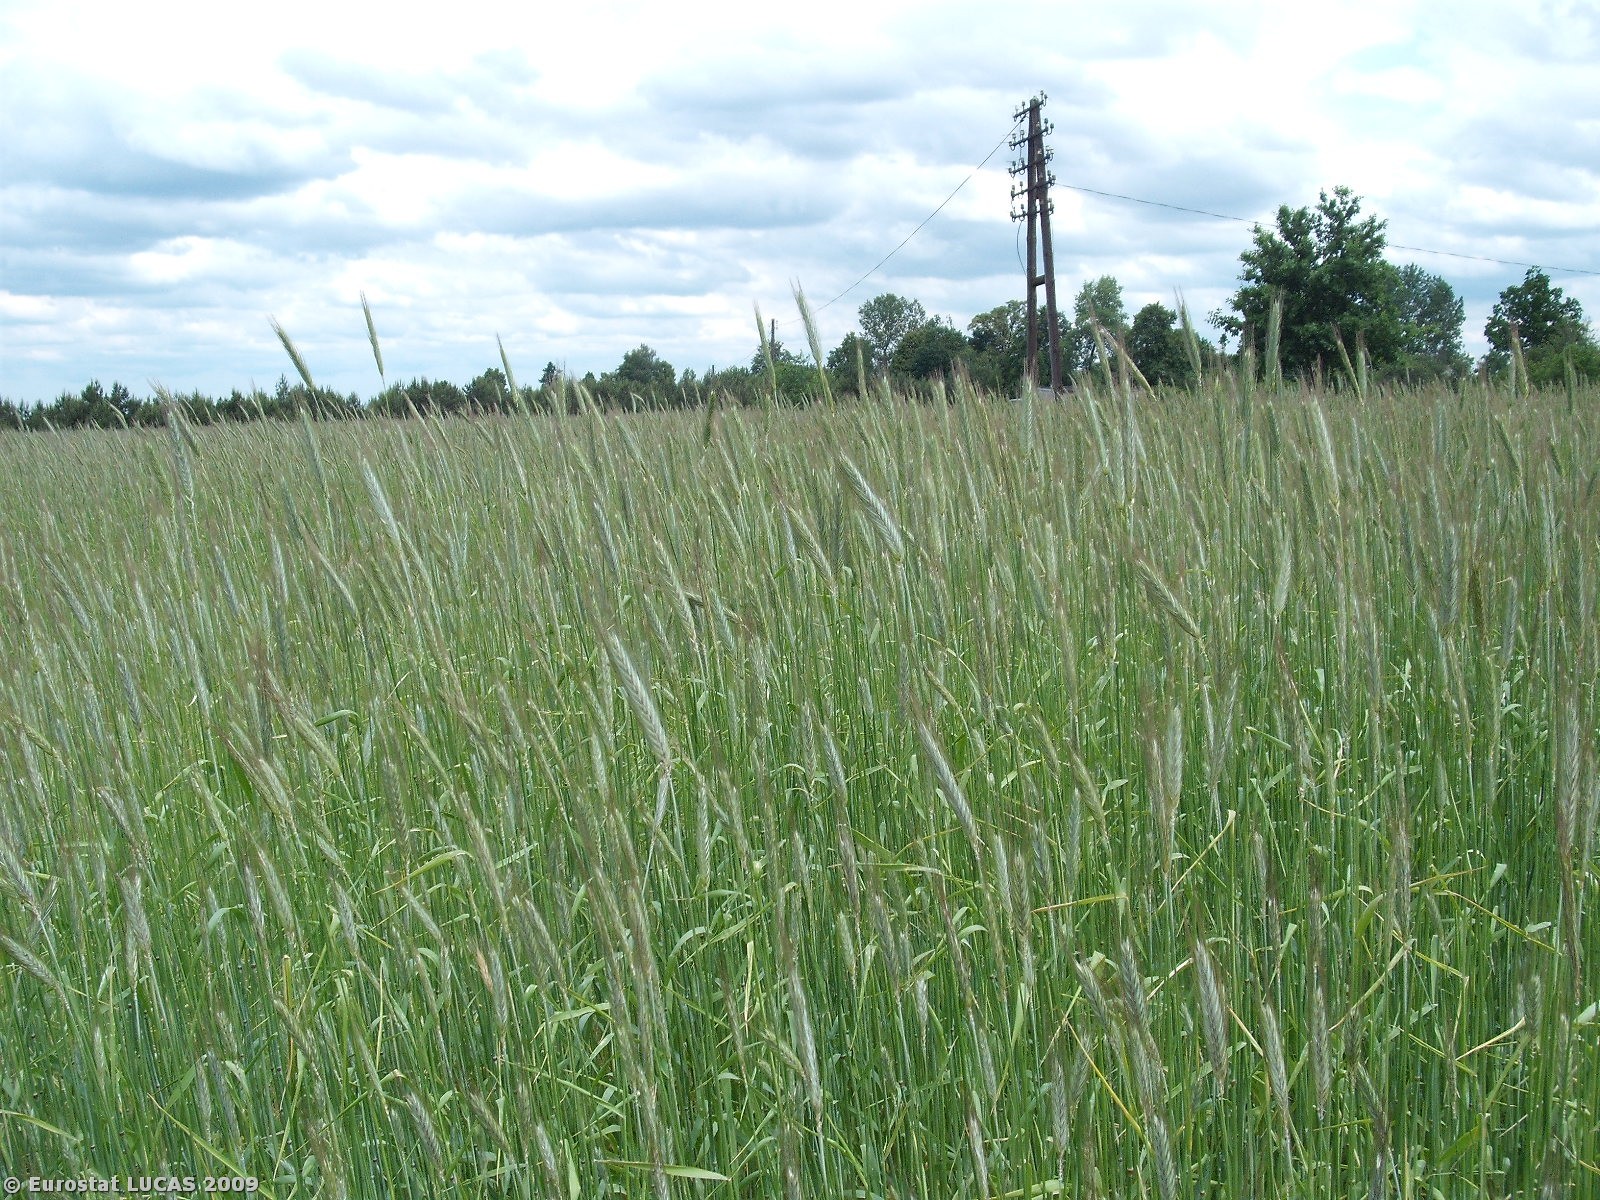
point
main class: Cropland
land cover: Rye
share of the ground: > 75 %
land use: Agriculture (excluding fallow land and kitchen gardens)
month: June
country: PL
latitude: 51.0908
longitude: 19.9265
